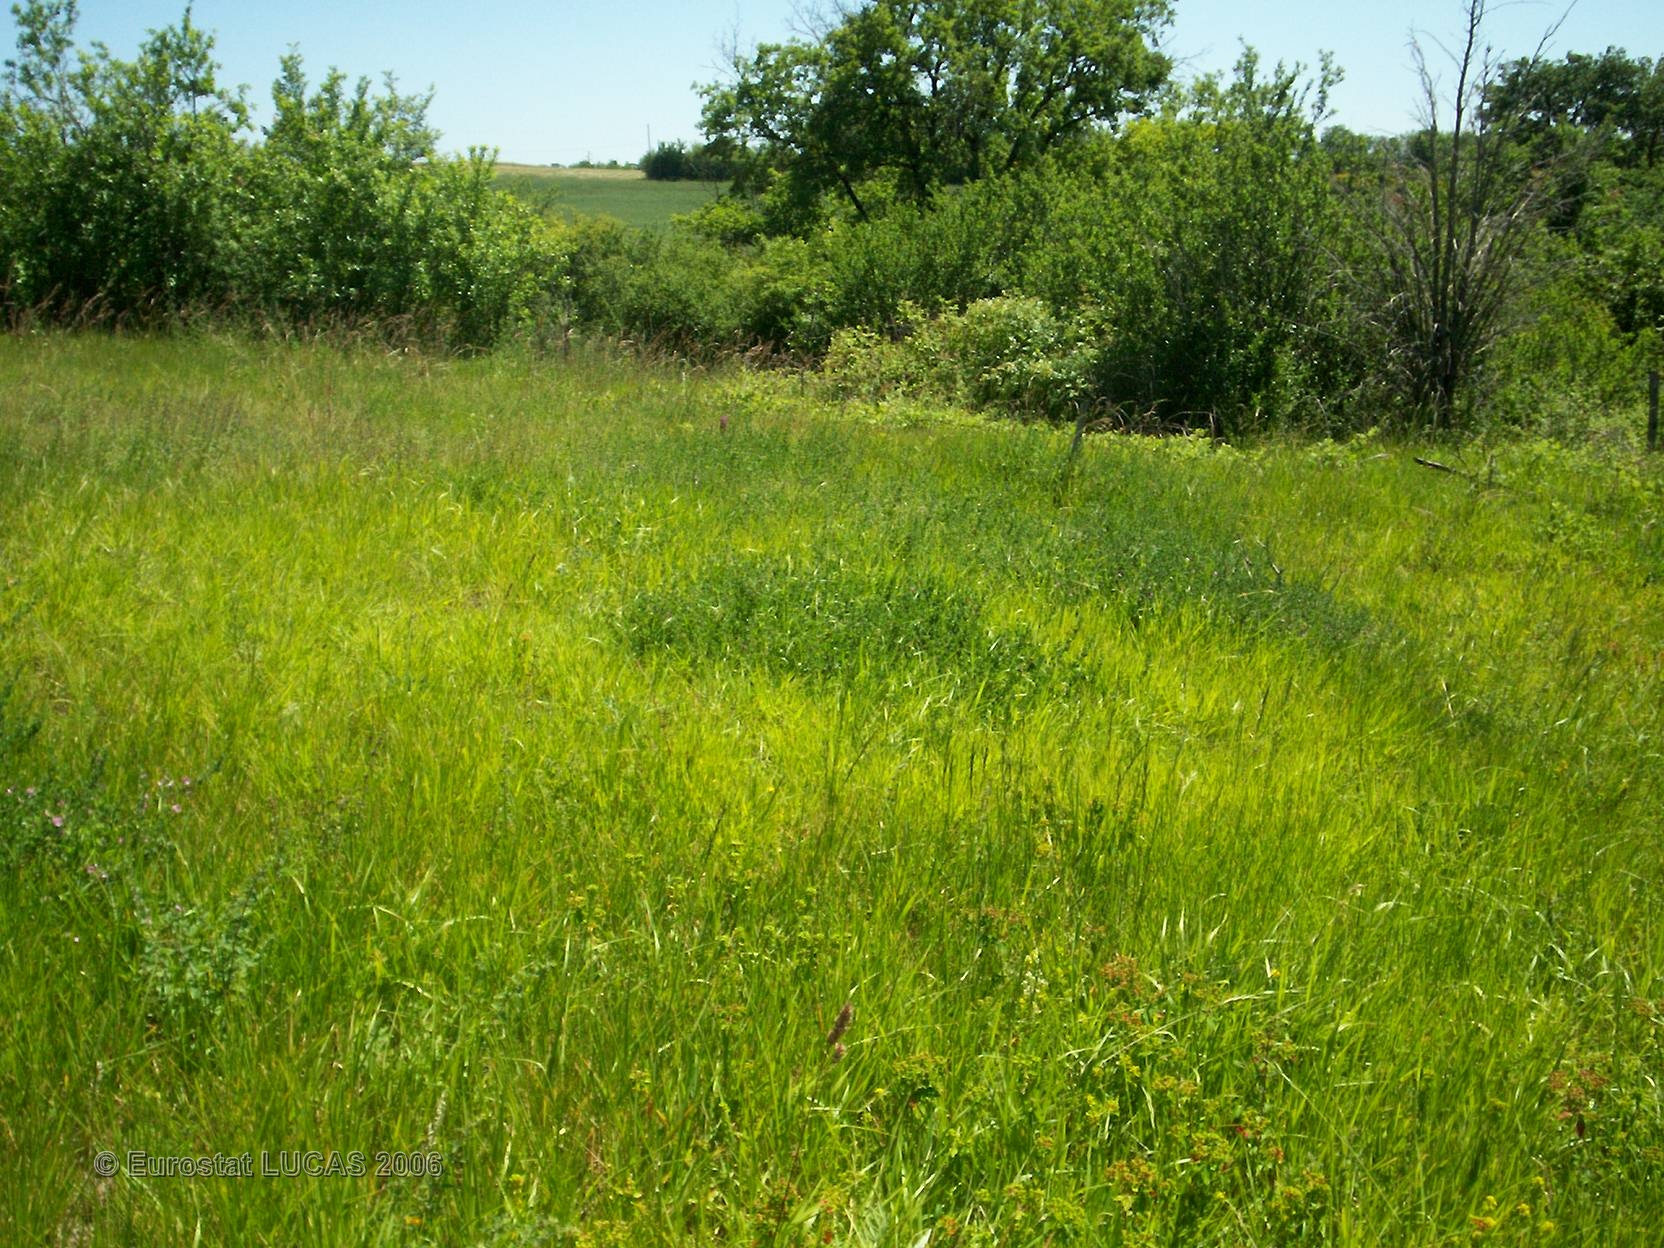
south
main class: Grassland
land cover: Grassland without tree/shrub cover
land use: Agriculture (excluding fallow land and kitchen gardens)
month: June
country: FR
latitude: 43.7793
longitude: 0.8163
